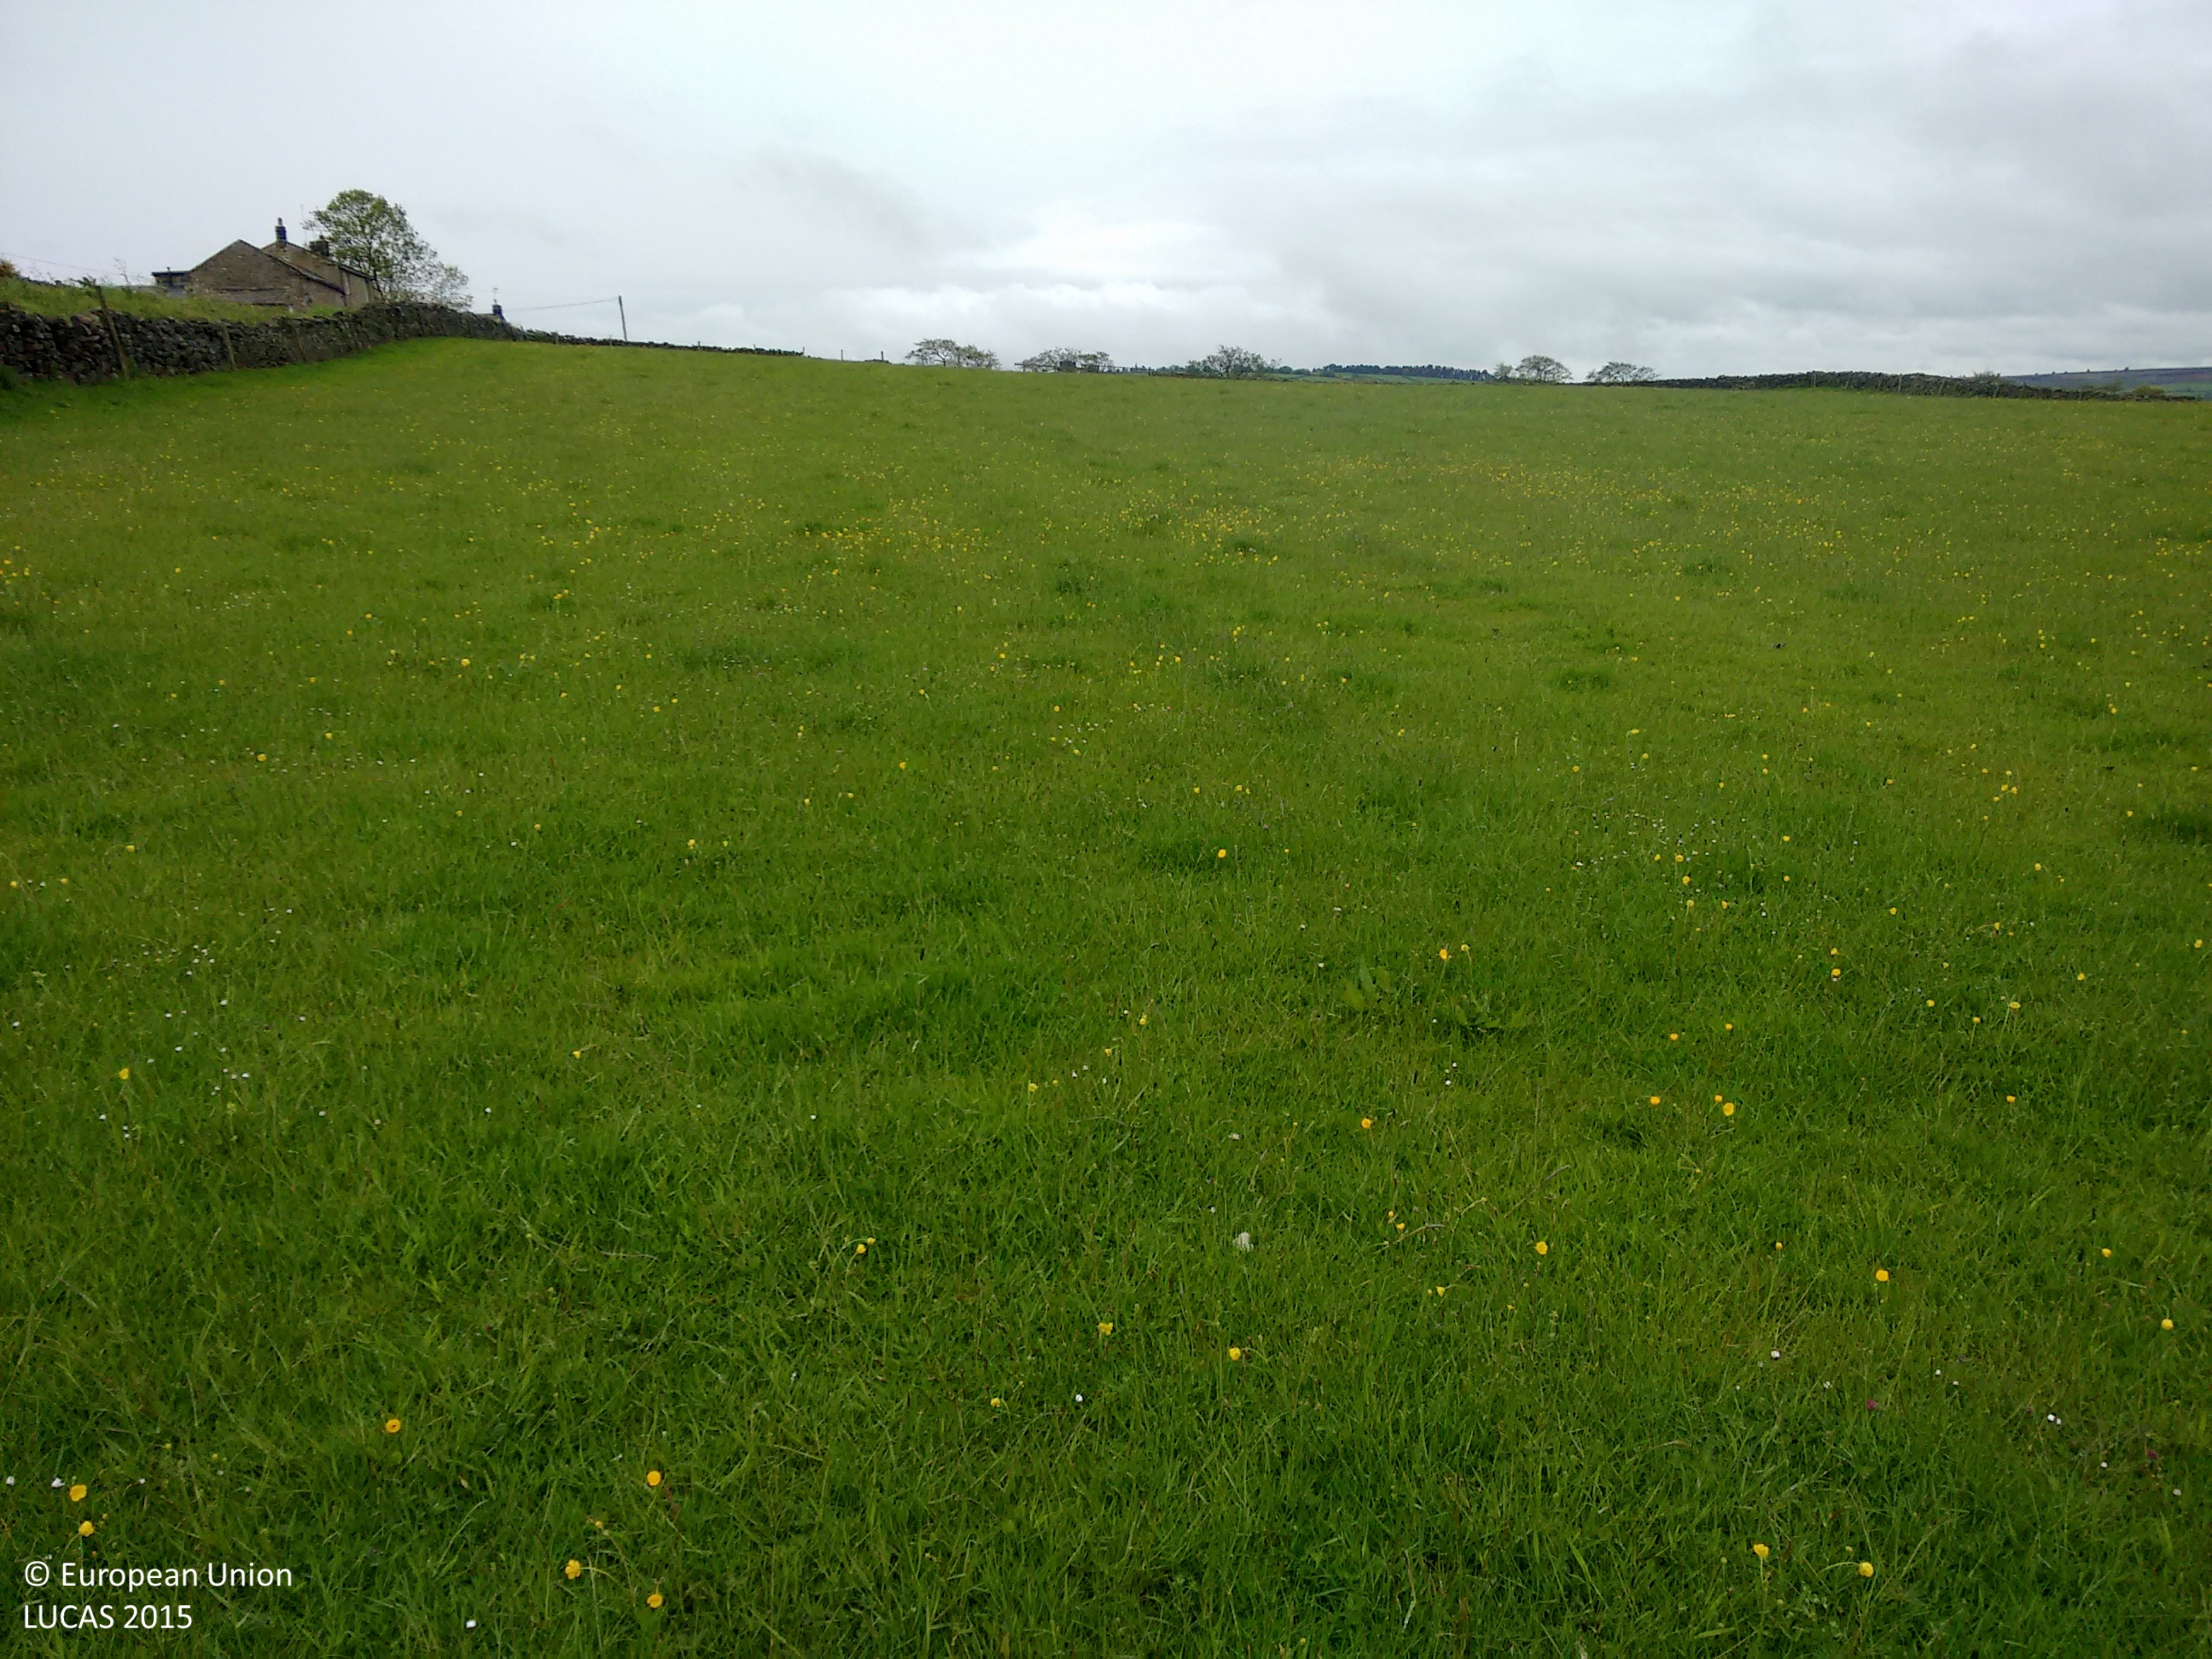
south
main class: Grassland
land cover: Grassland without tree/shrub cover
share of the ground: > 75 %
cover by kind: herbaceous plants 100 %
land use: Agriculture (excluding fallow land and kitchen gardens)
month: May
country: GB
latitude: 53.9789
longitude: -1.6862
